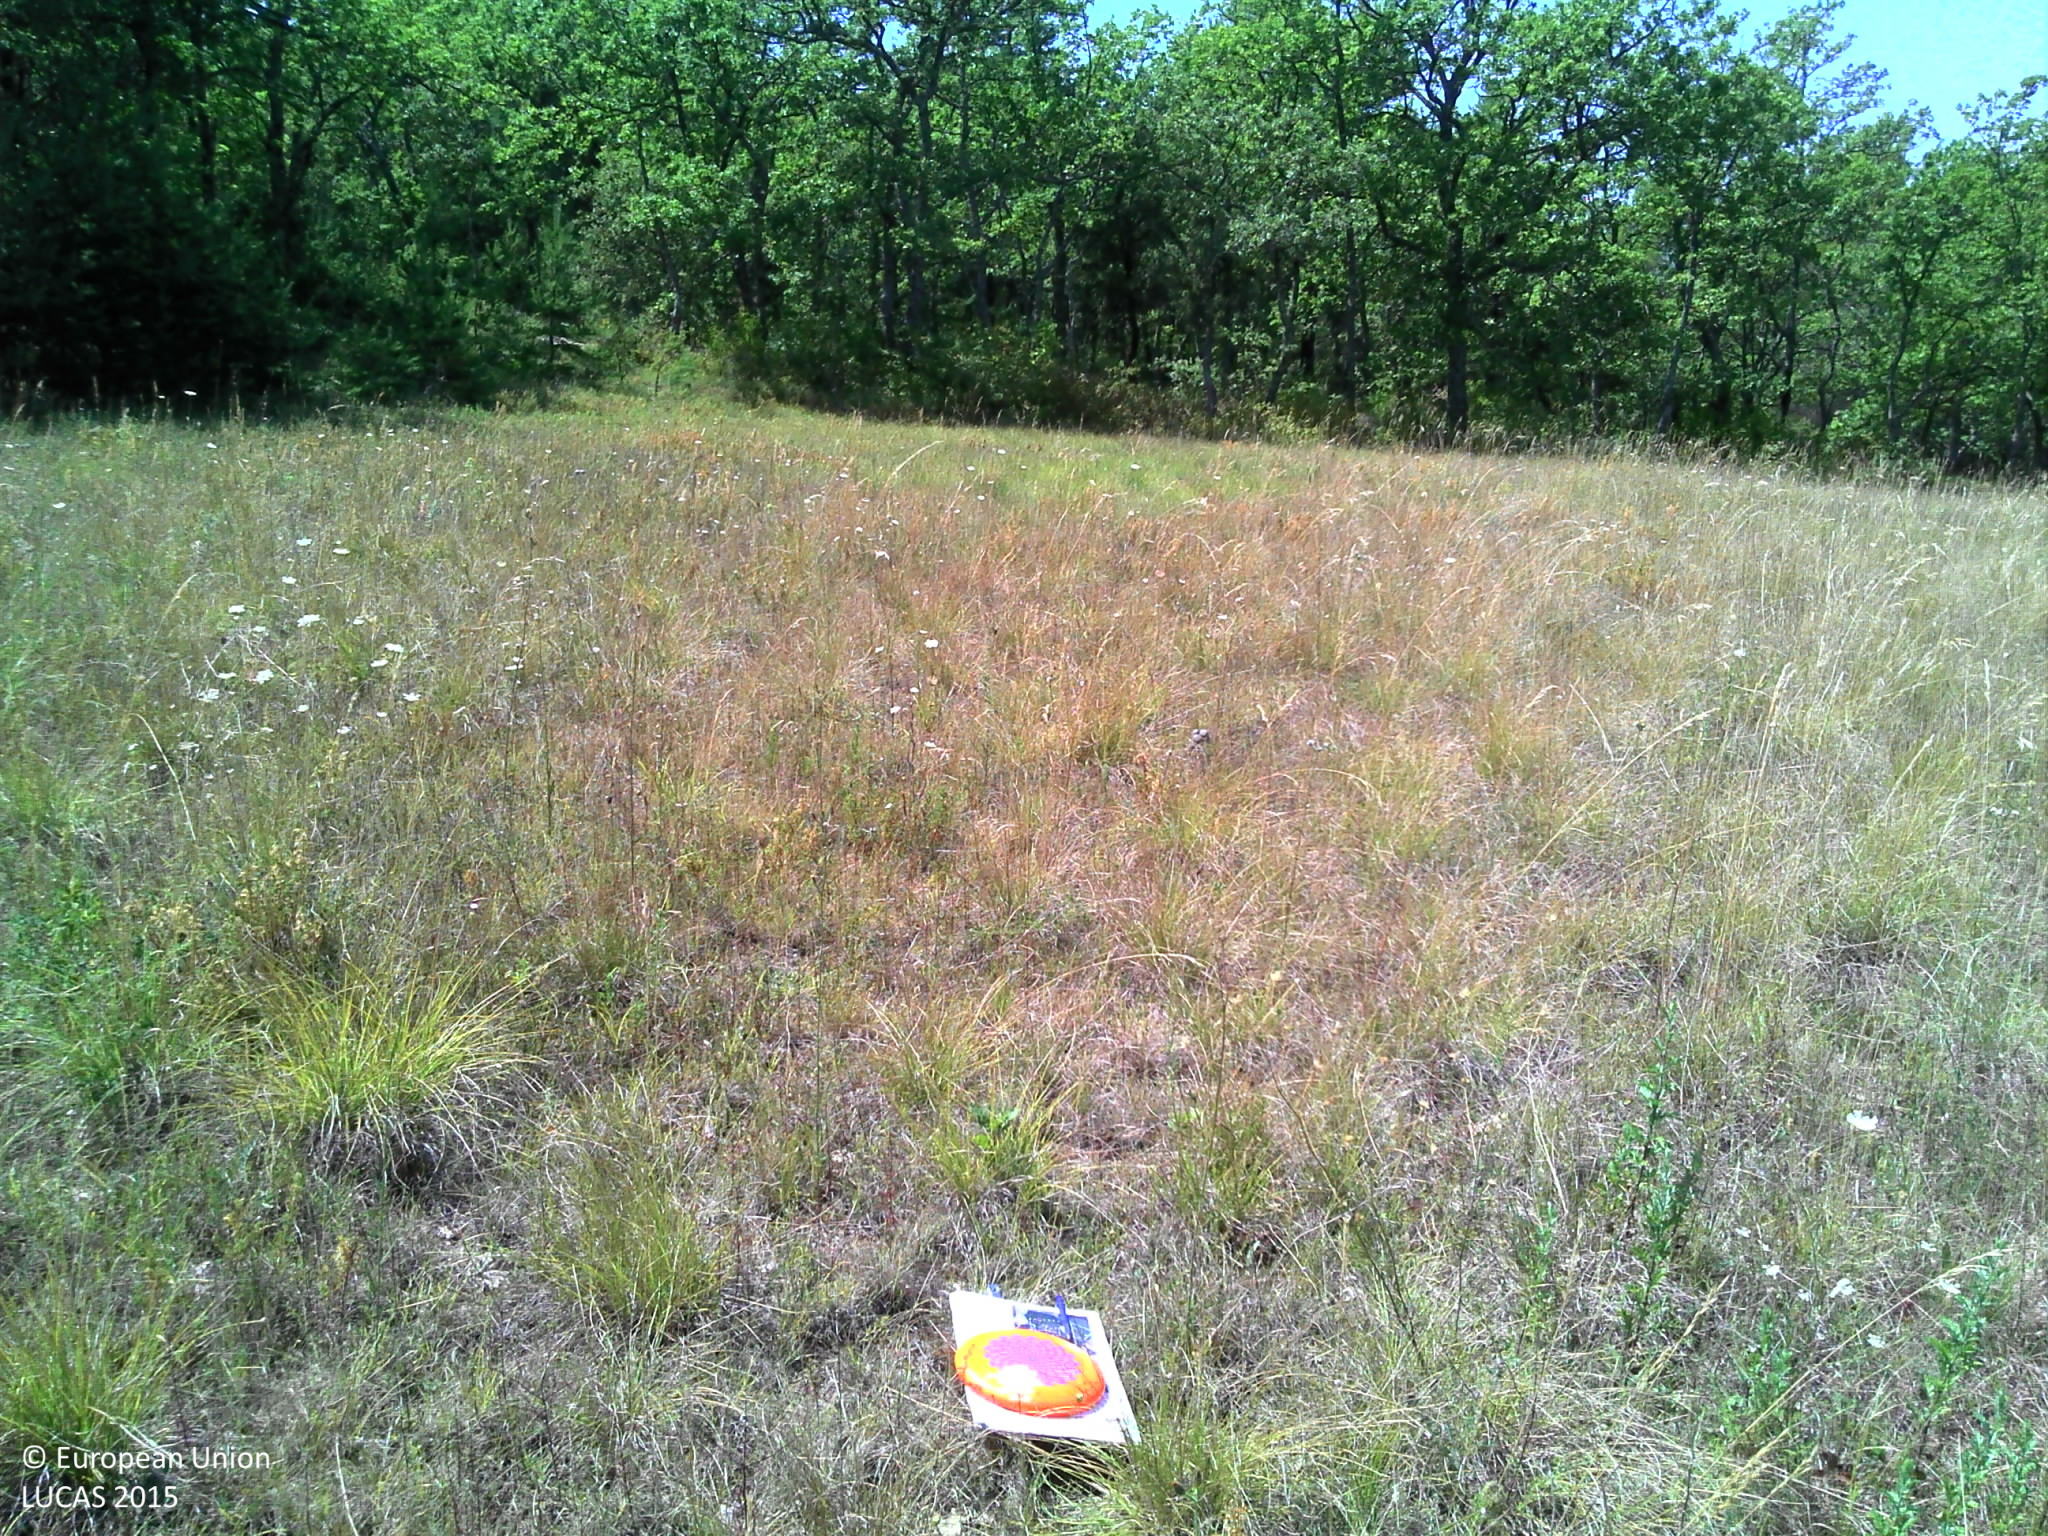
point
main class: Grassland
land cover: Spontaneously vegetated surfaces
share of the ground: > 75 %
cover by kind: herbaceous plants 95 %, lichens and mosses 5 %
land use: Semi-natural and natural areas not in use
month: August
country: FR
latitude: 43.8452
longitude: 5.2697
